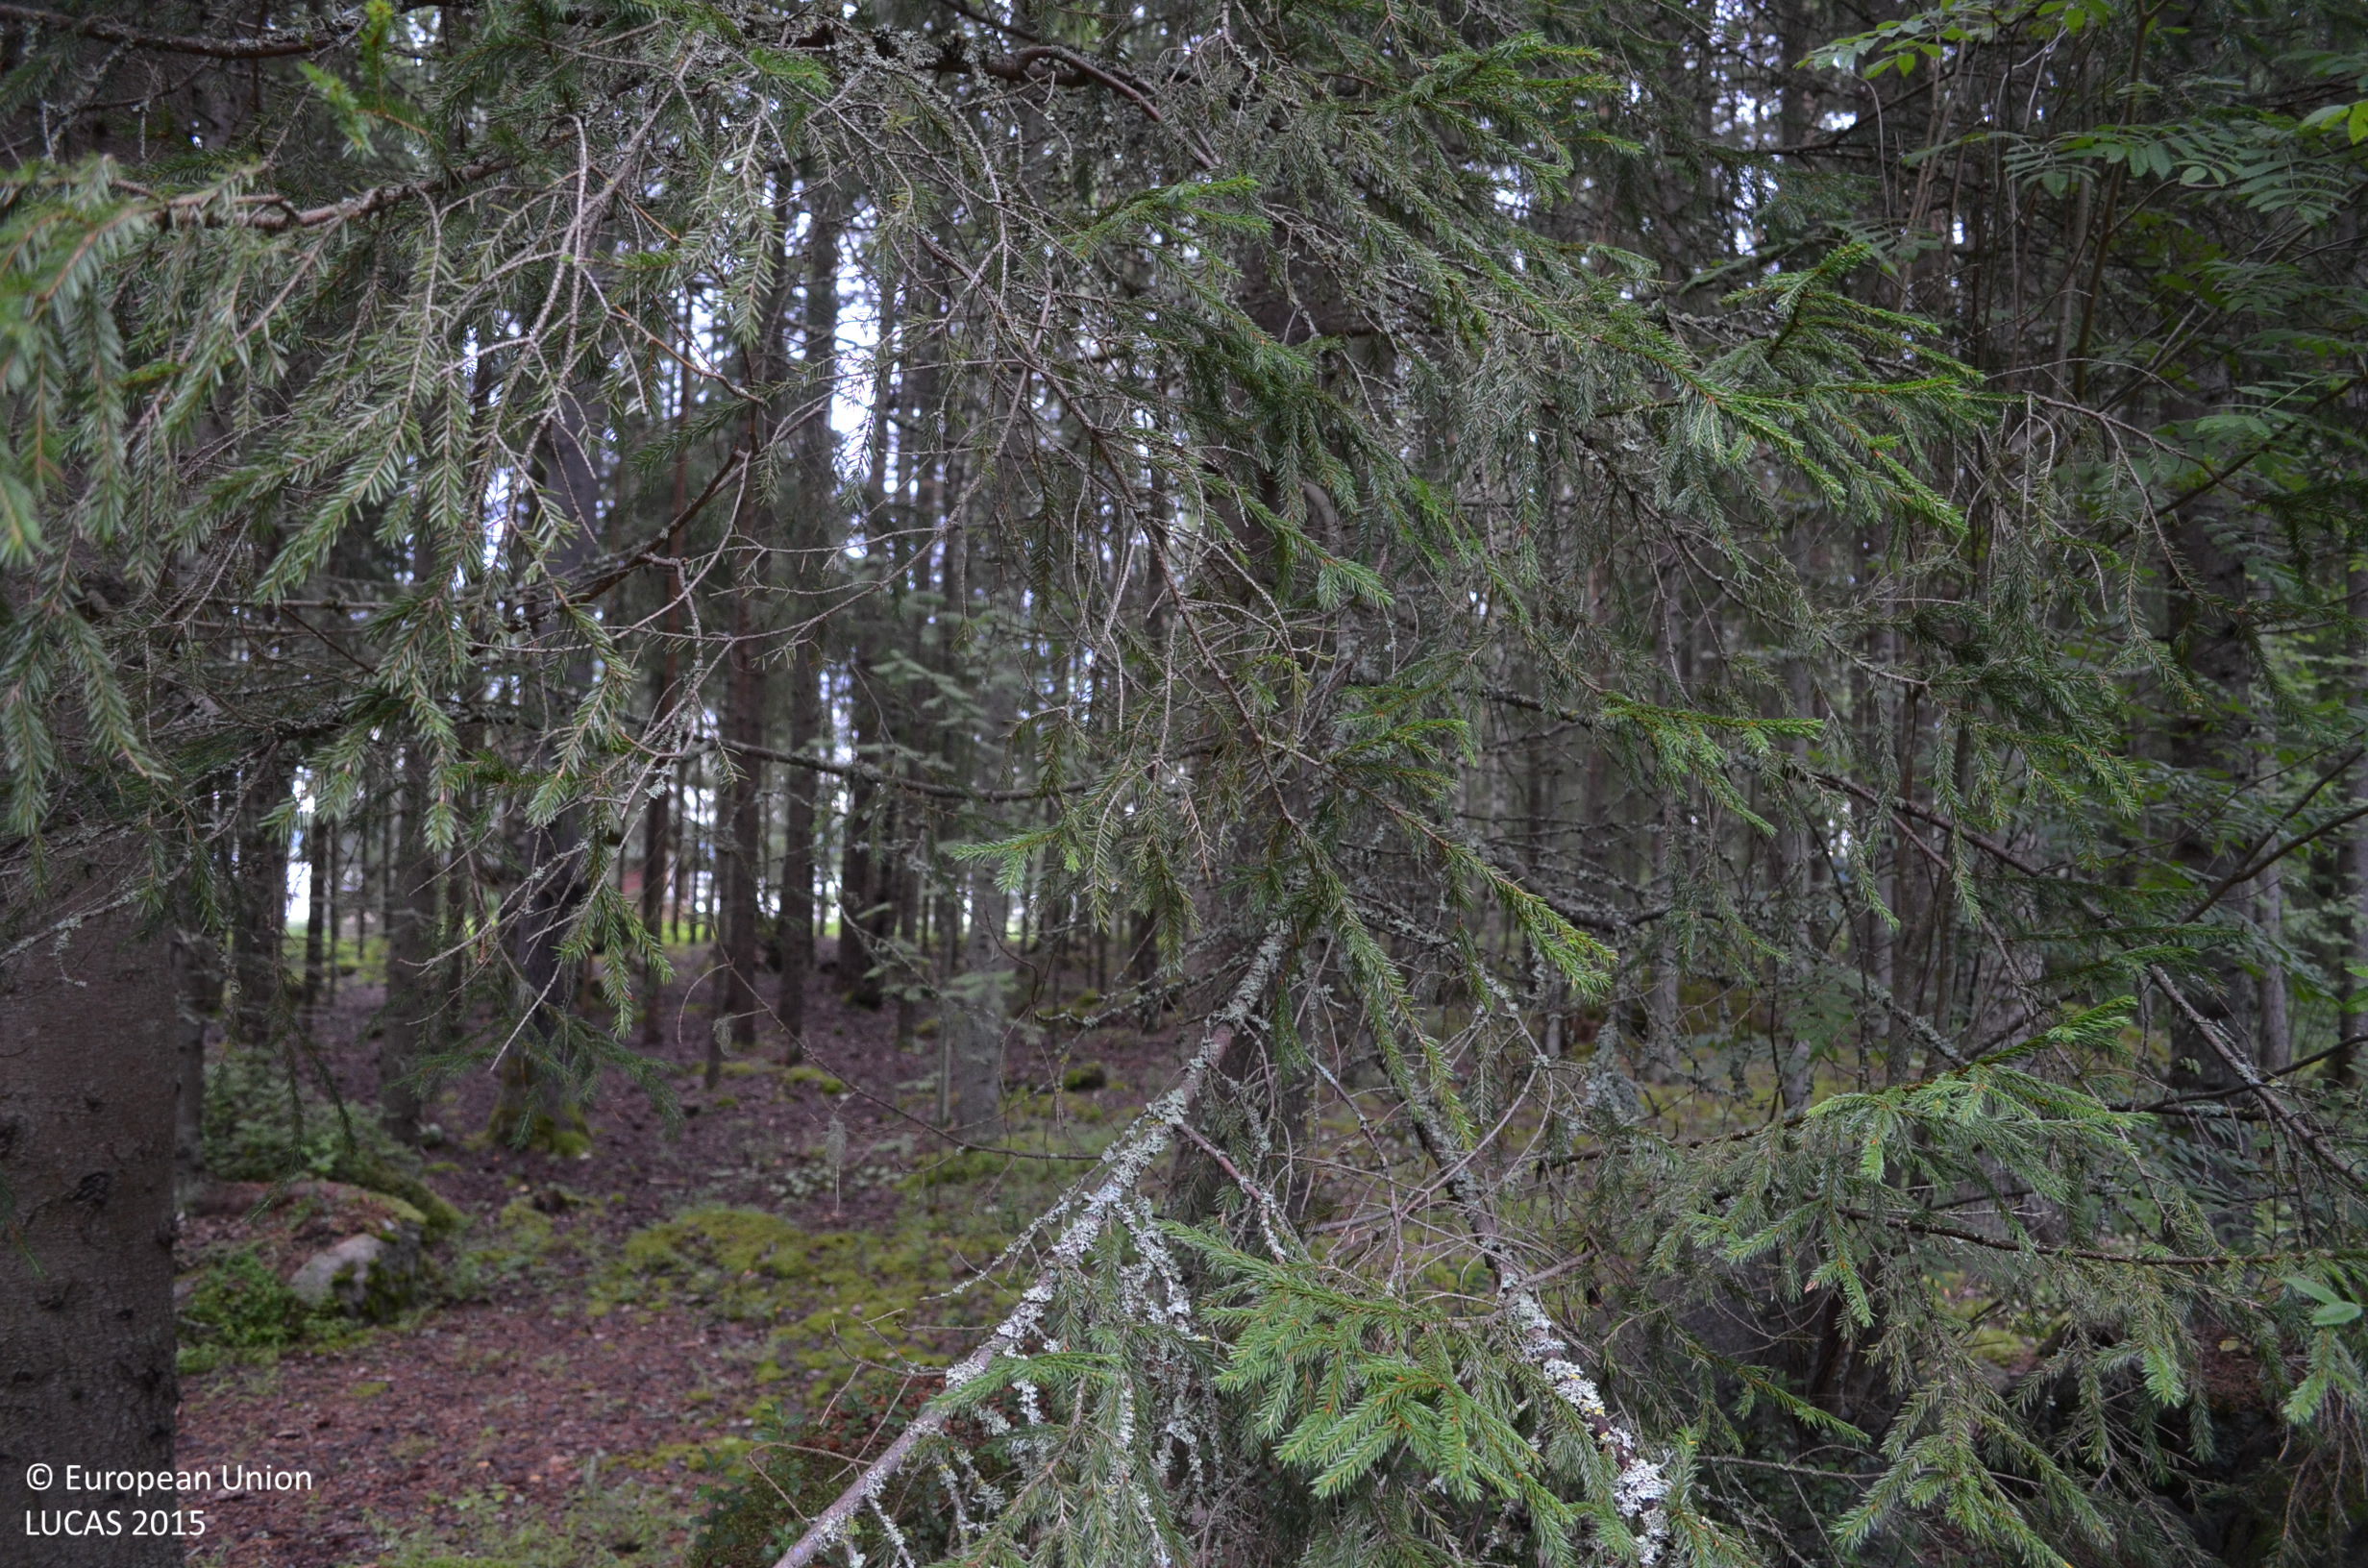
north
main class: Woodland
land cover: Spruce dominated coniferous woodland
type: boreal forest
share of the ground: > 75 %
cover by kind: coniferous forest trees 75 %, shrubs 15 %, broadleaved forest trees 10 %
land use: Forestry
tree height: > 5 m
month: July
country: FI
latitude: 62.0363
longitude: 24.0983
